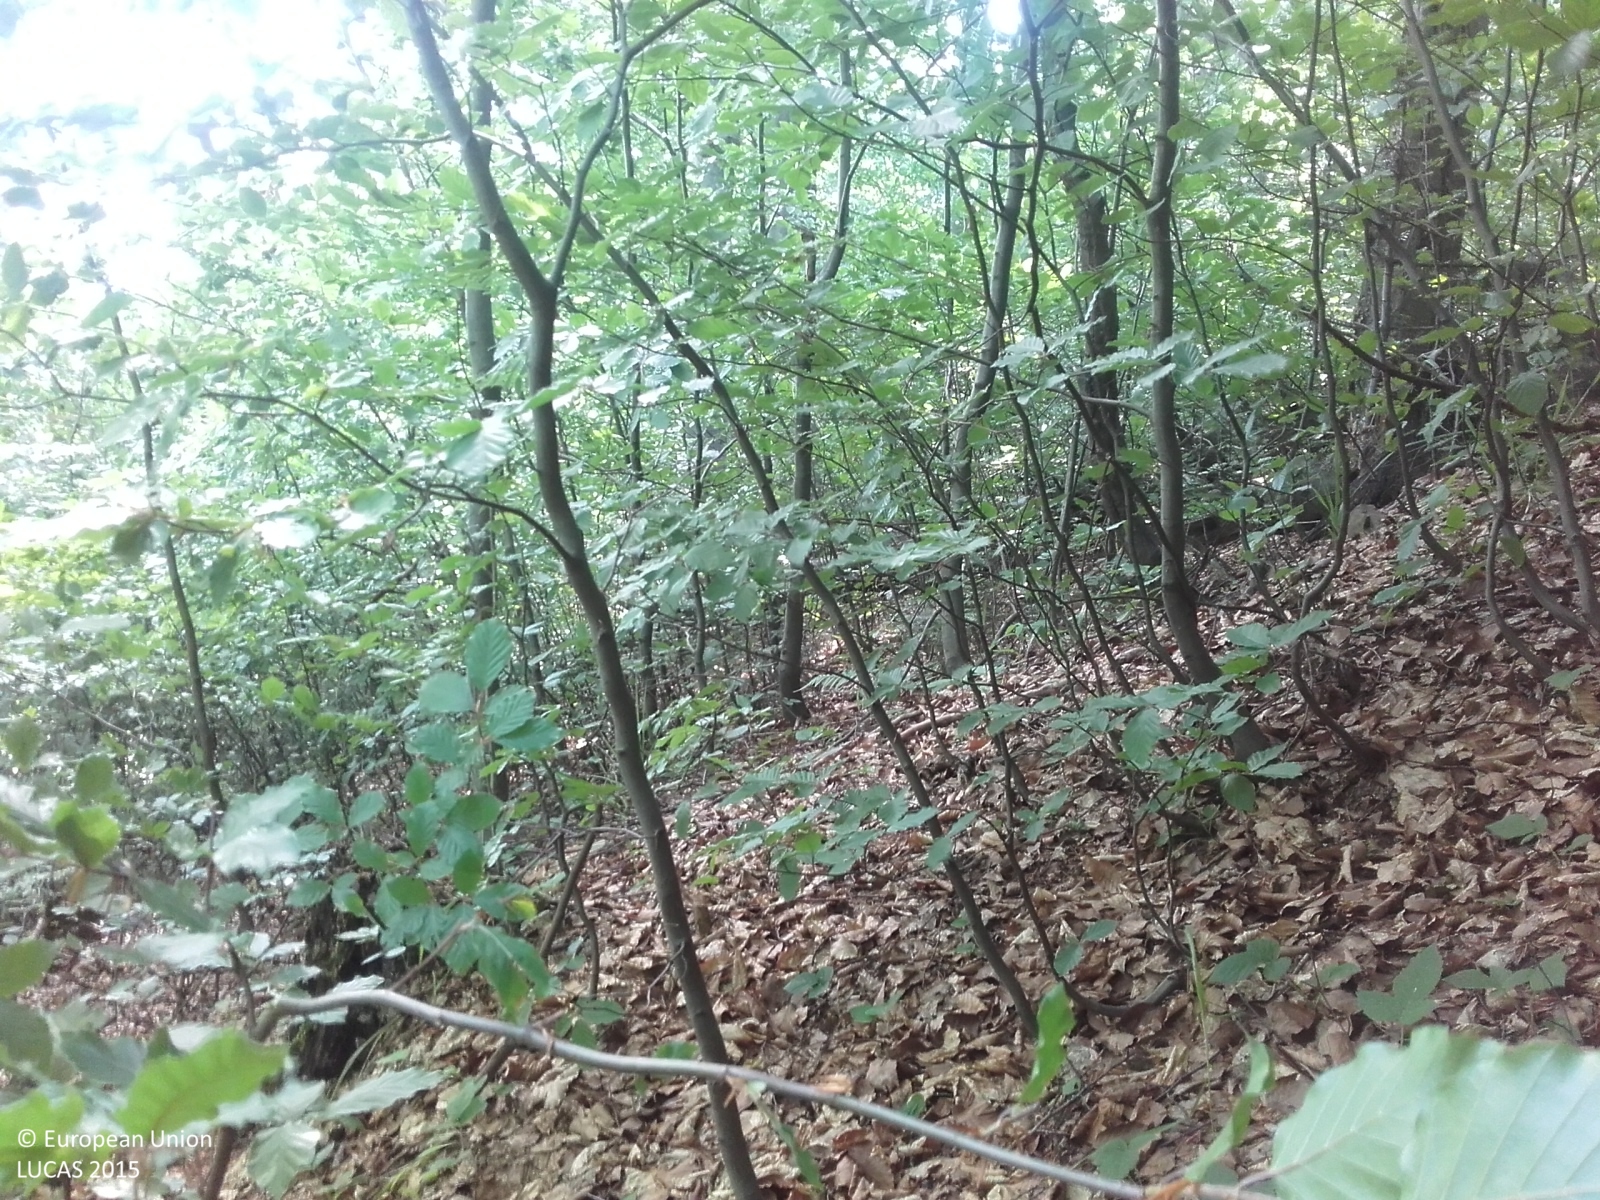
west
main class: Woodland
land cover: Broadleaved woodland
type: mesophytic deciduous forest
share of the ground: > 75 %
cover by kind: broadleaved forest trees 100 %
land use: Forestry
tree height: > 5 m
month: June
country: CZ
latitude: 49.6076
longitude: 18.8083
